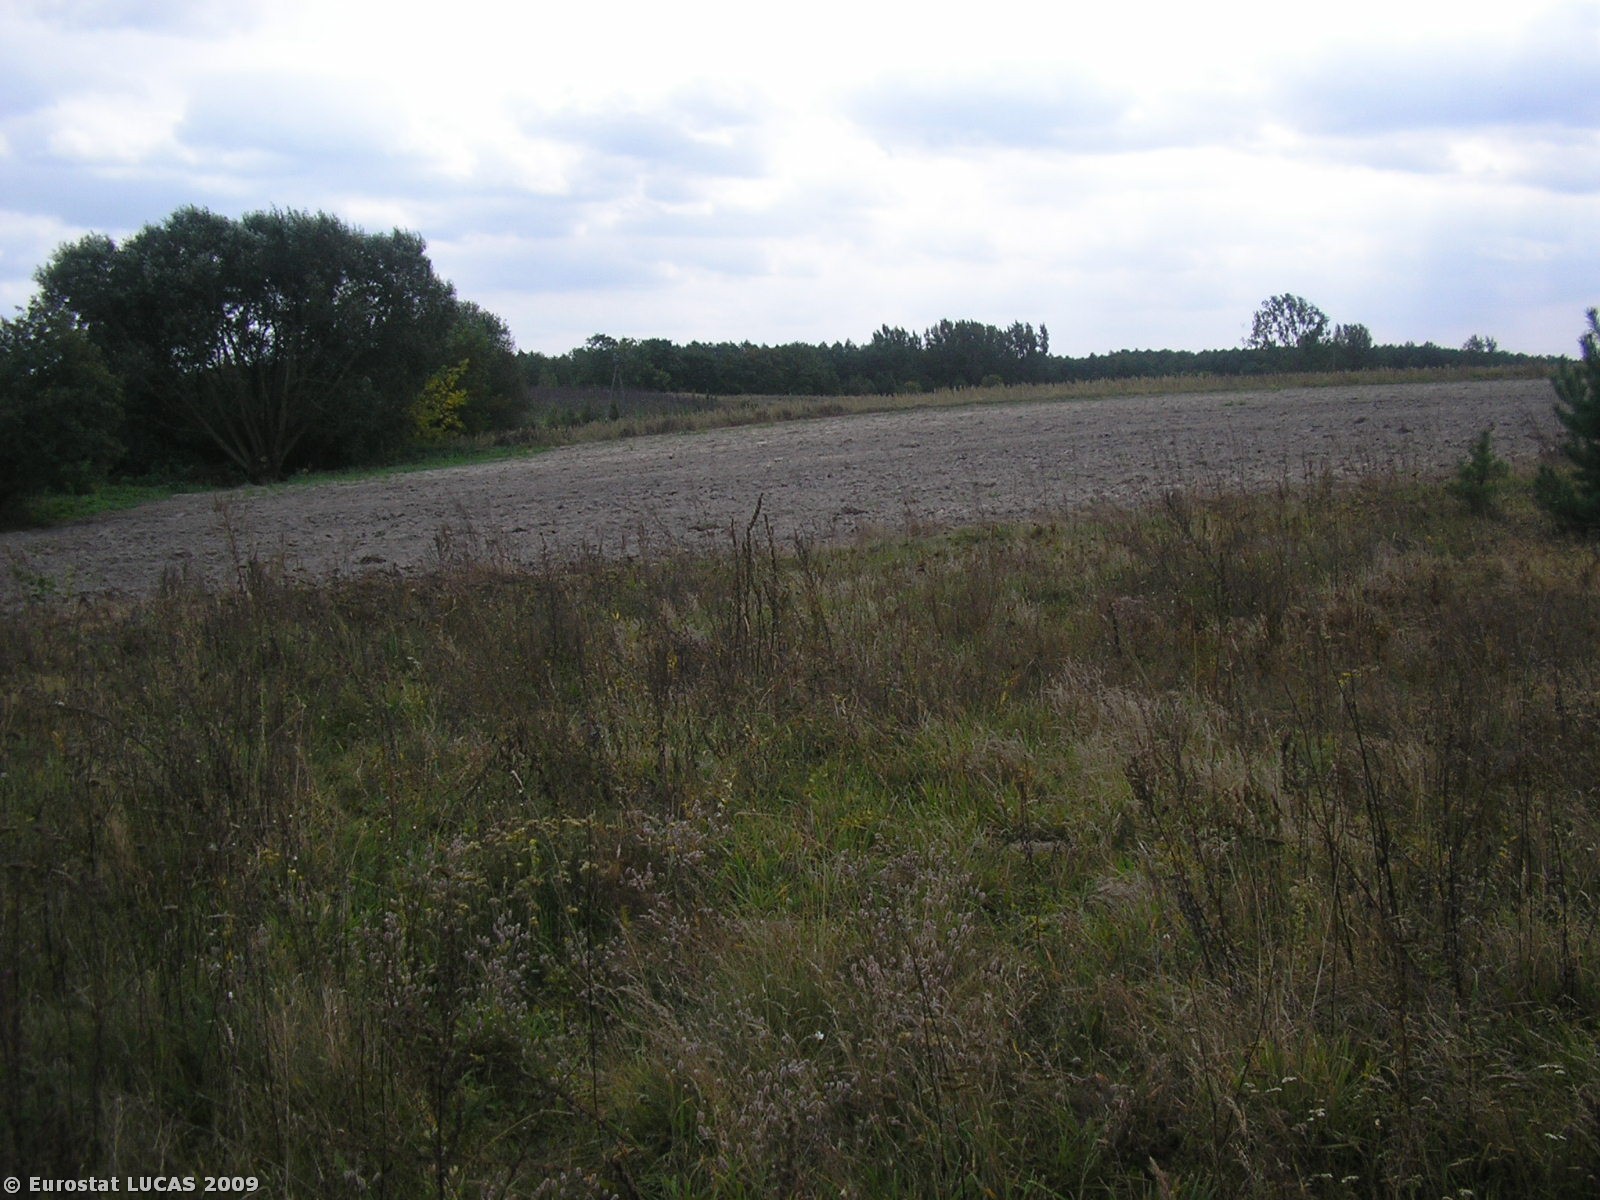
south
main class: Grassland
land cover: Grassland without tree/shrub cover
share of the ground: > 75 %
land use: Unused
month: September
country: PL
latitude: 51.6864
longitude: 20.9649
